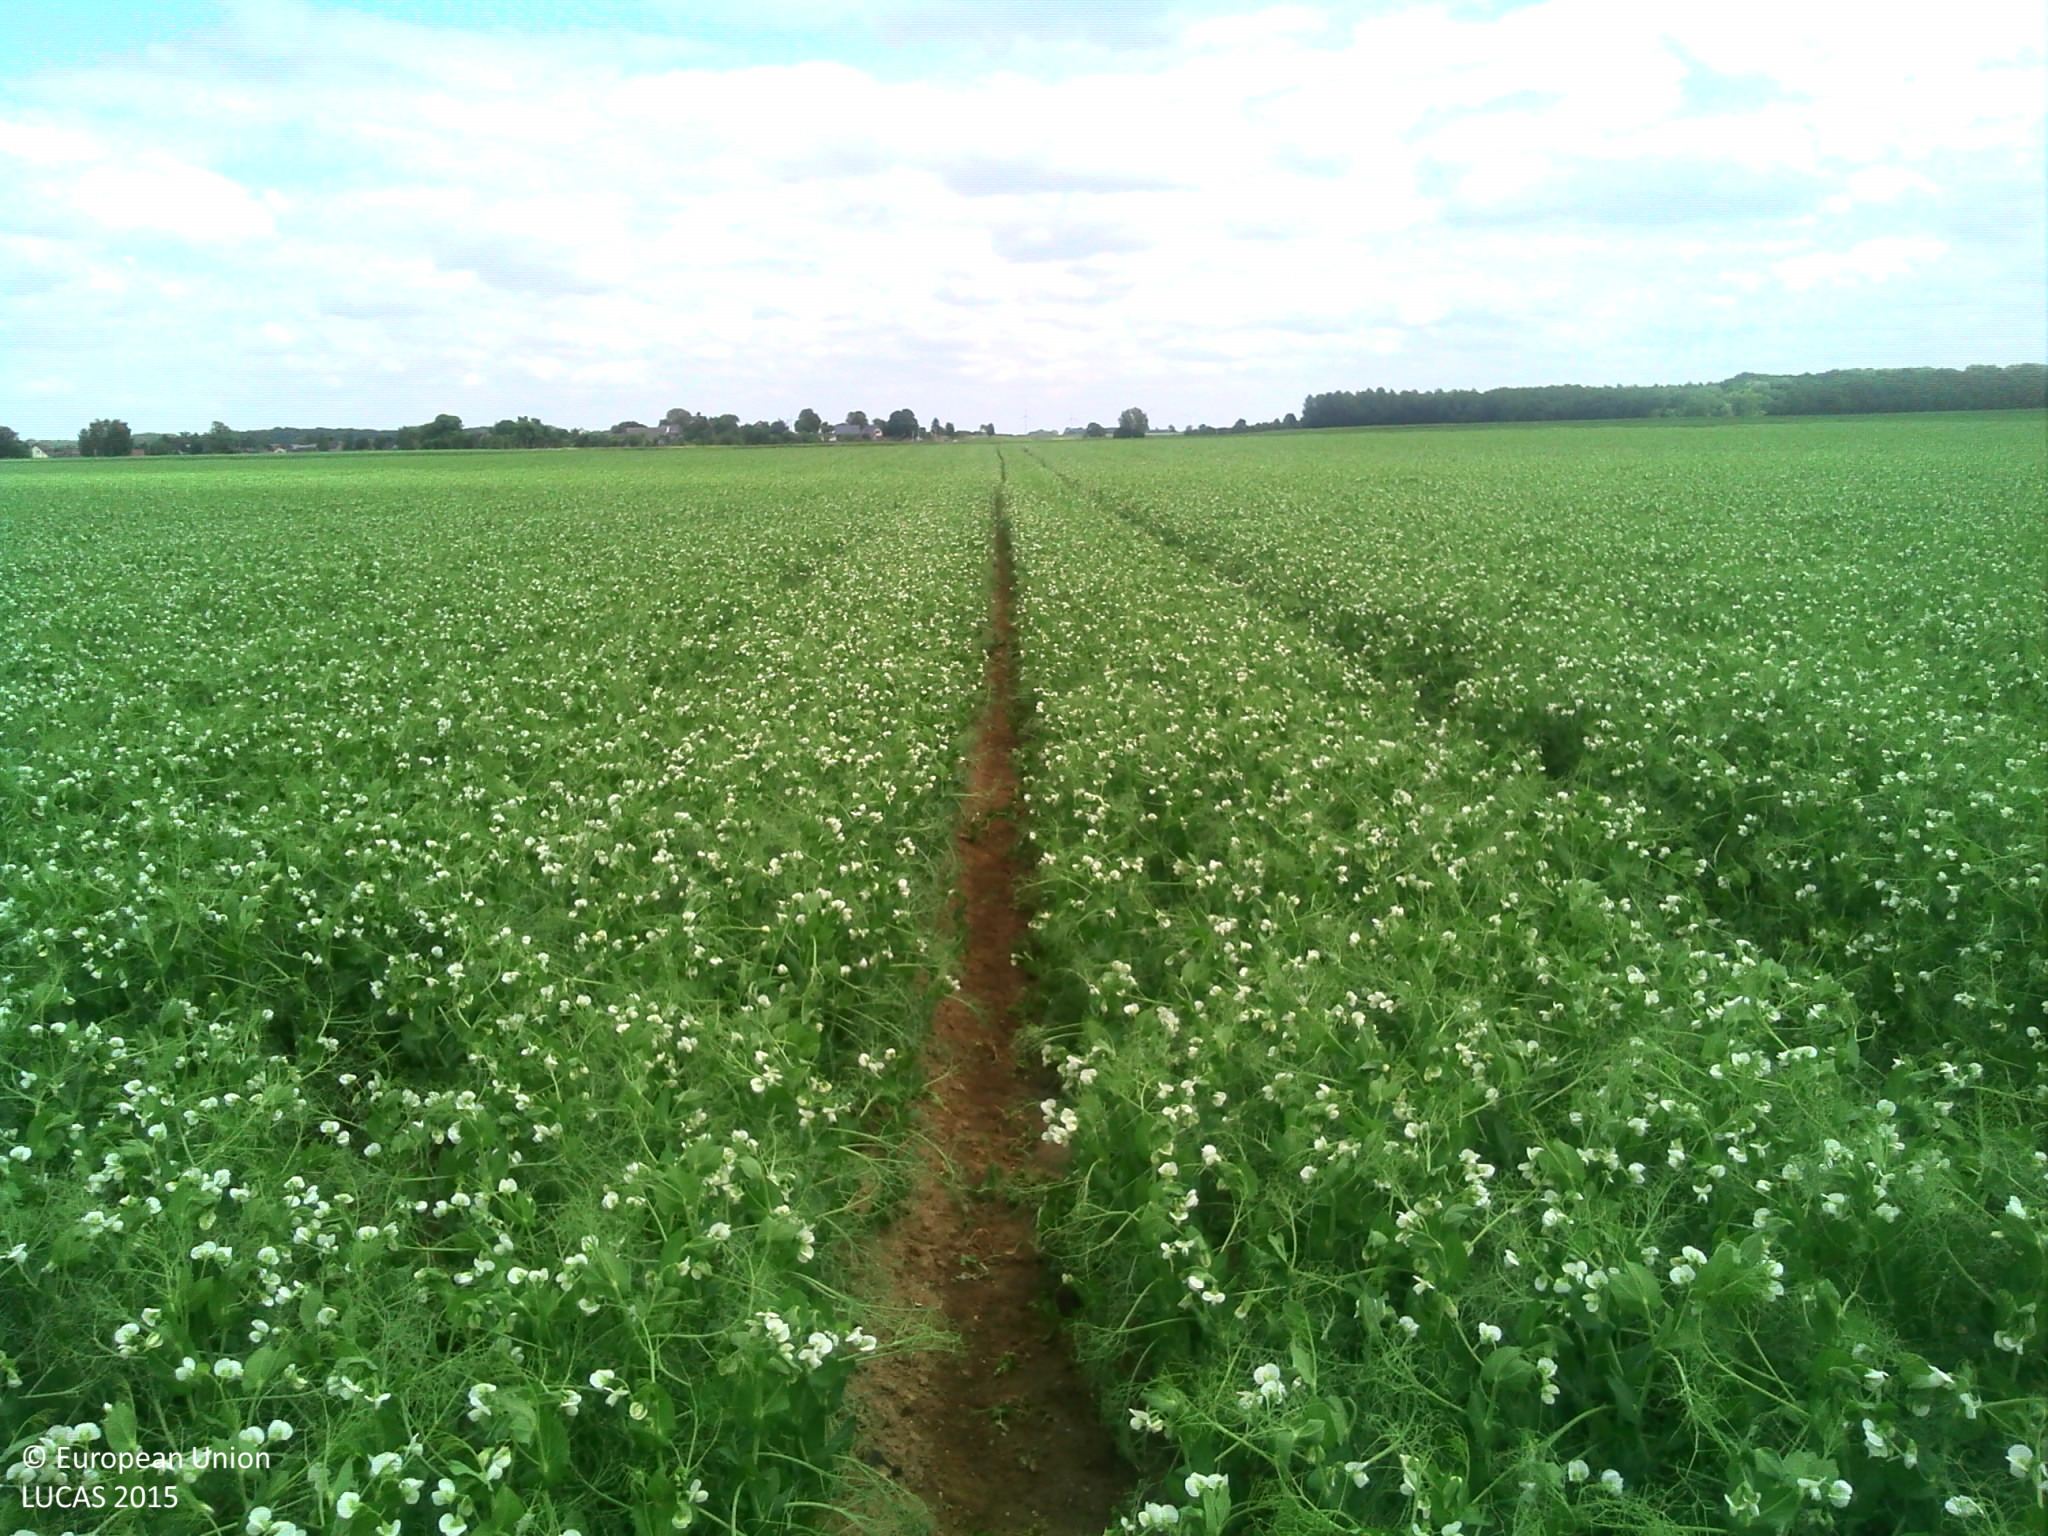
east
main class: Cropland
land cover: Dry pulses
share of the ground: > 75 %
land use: Agriculture (excluding fallow land and kitchen gardens)
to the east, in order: Dry pulses
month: June
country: FR
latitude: 49.7111
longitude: 3.2100
